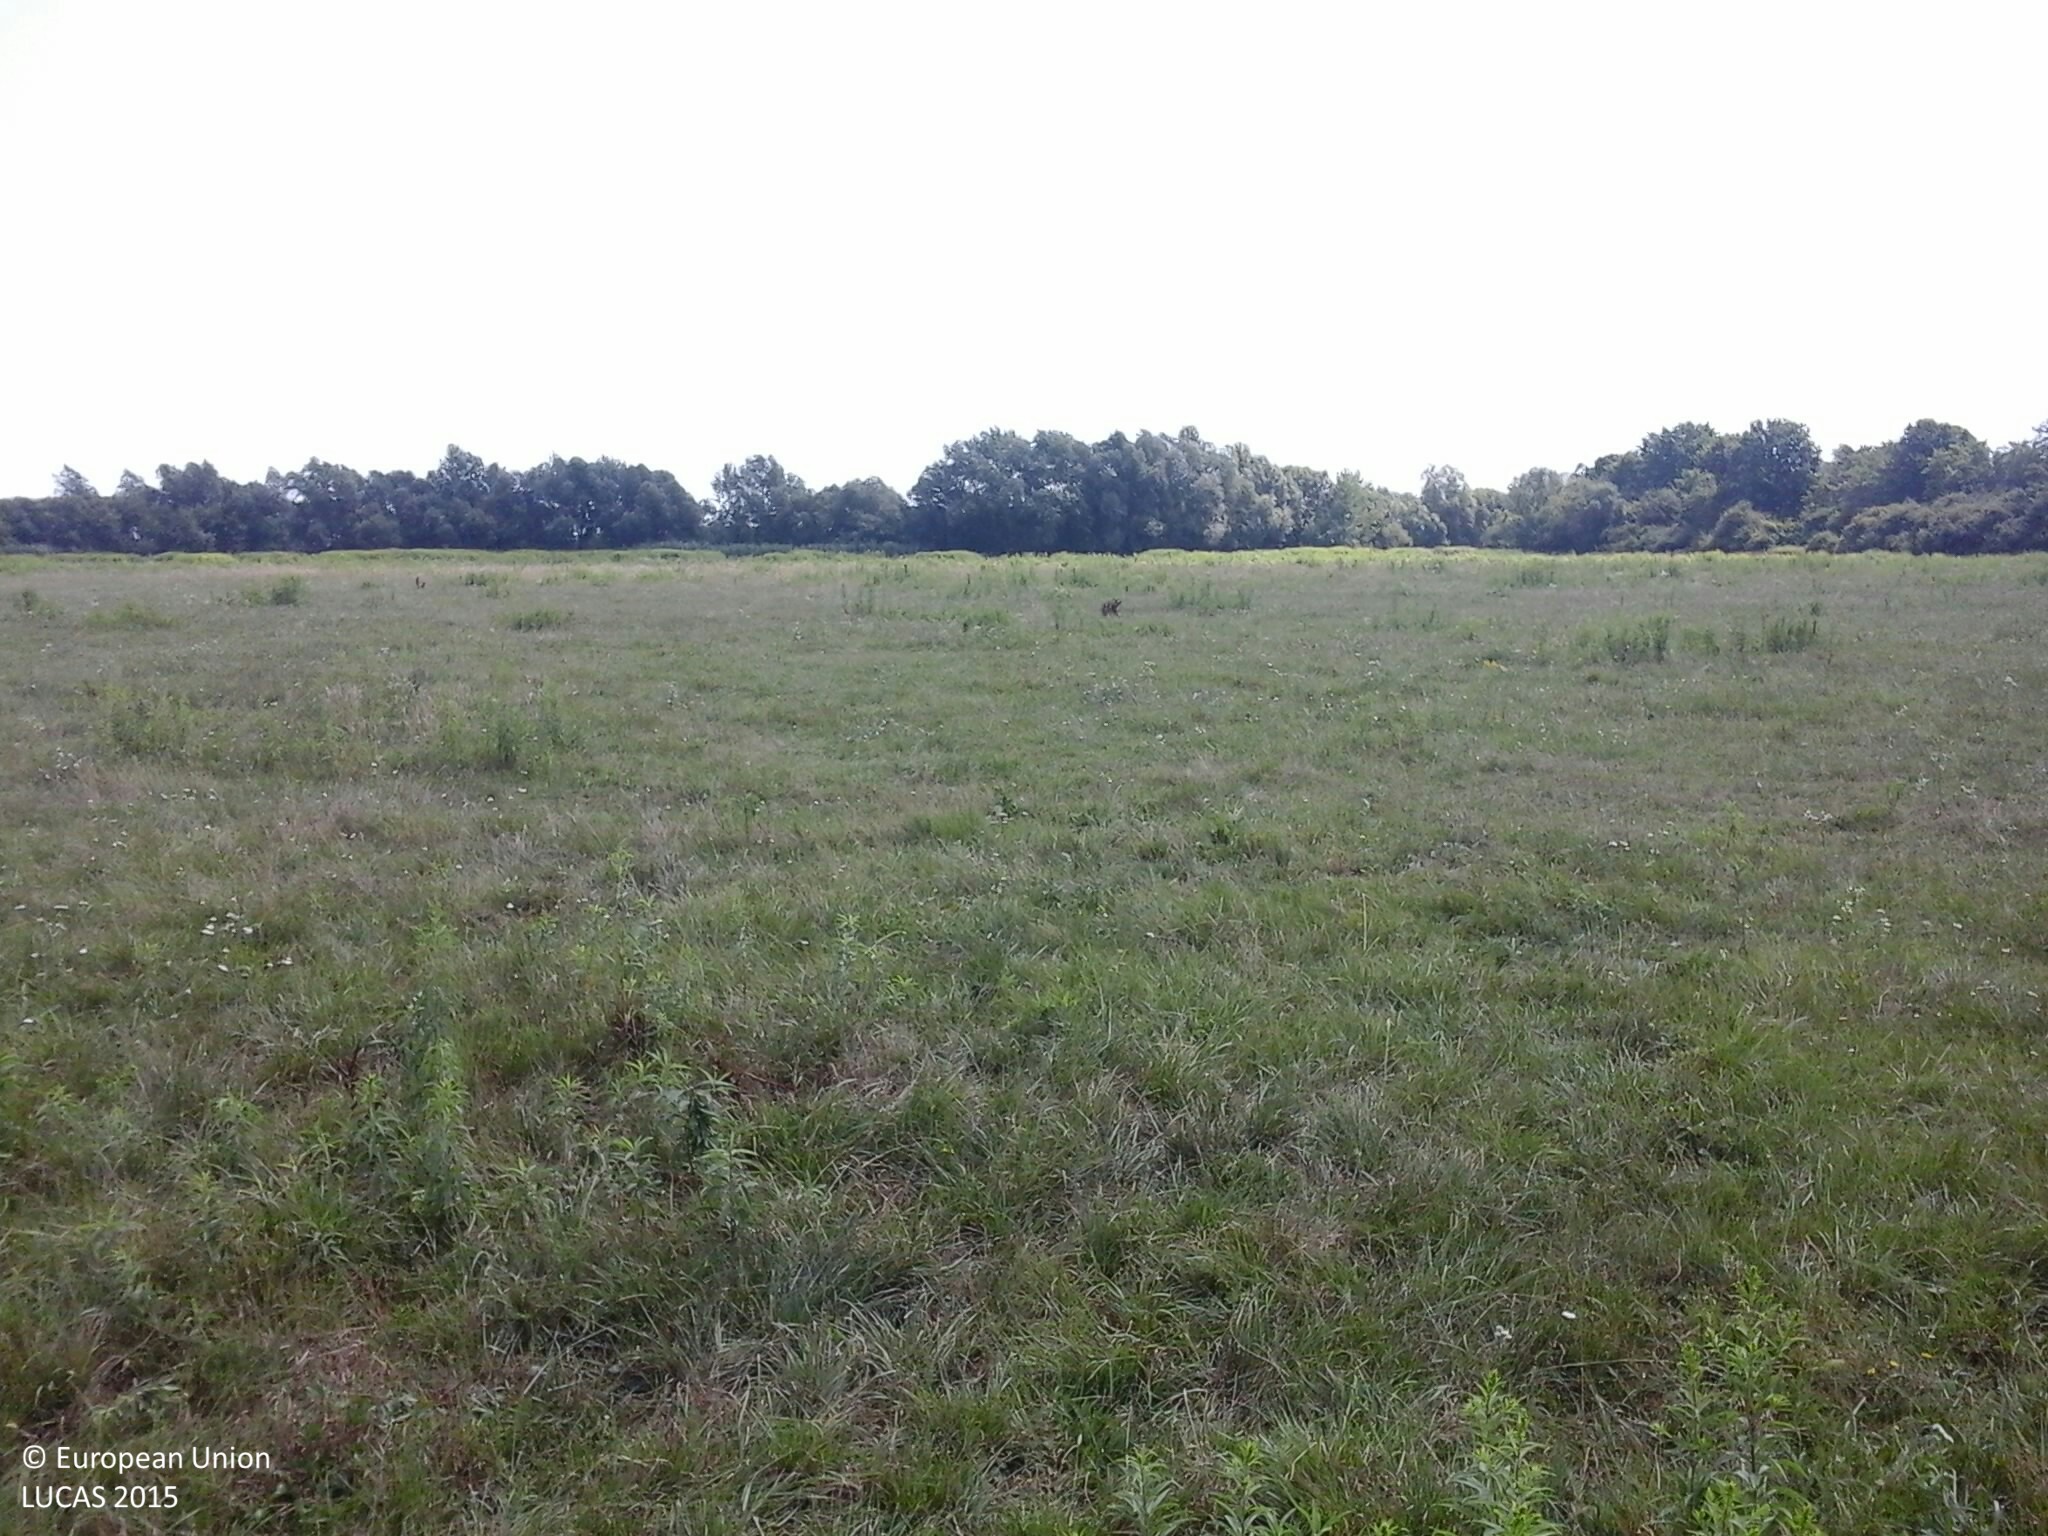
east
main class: Grassland
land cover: Grassland without tree/shrub cover
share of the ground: > 75 %
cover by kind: herbaceous plants 100 %
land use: Agriculture (excluding fallow land and kitchen gardens)
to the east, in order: Grassland without tree/shrub cover
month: July
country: HU
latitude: 47.0407
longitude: 16.4646
